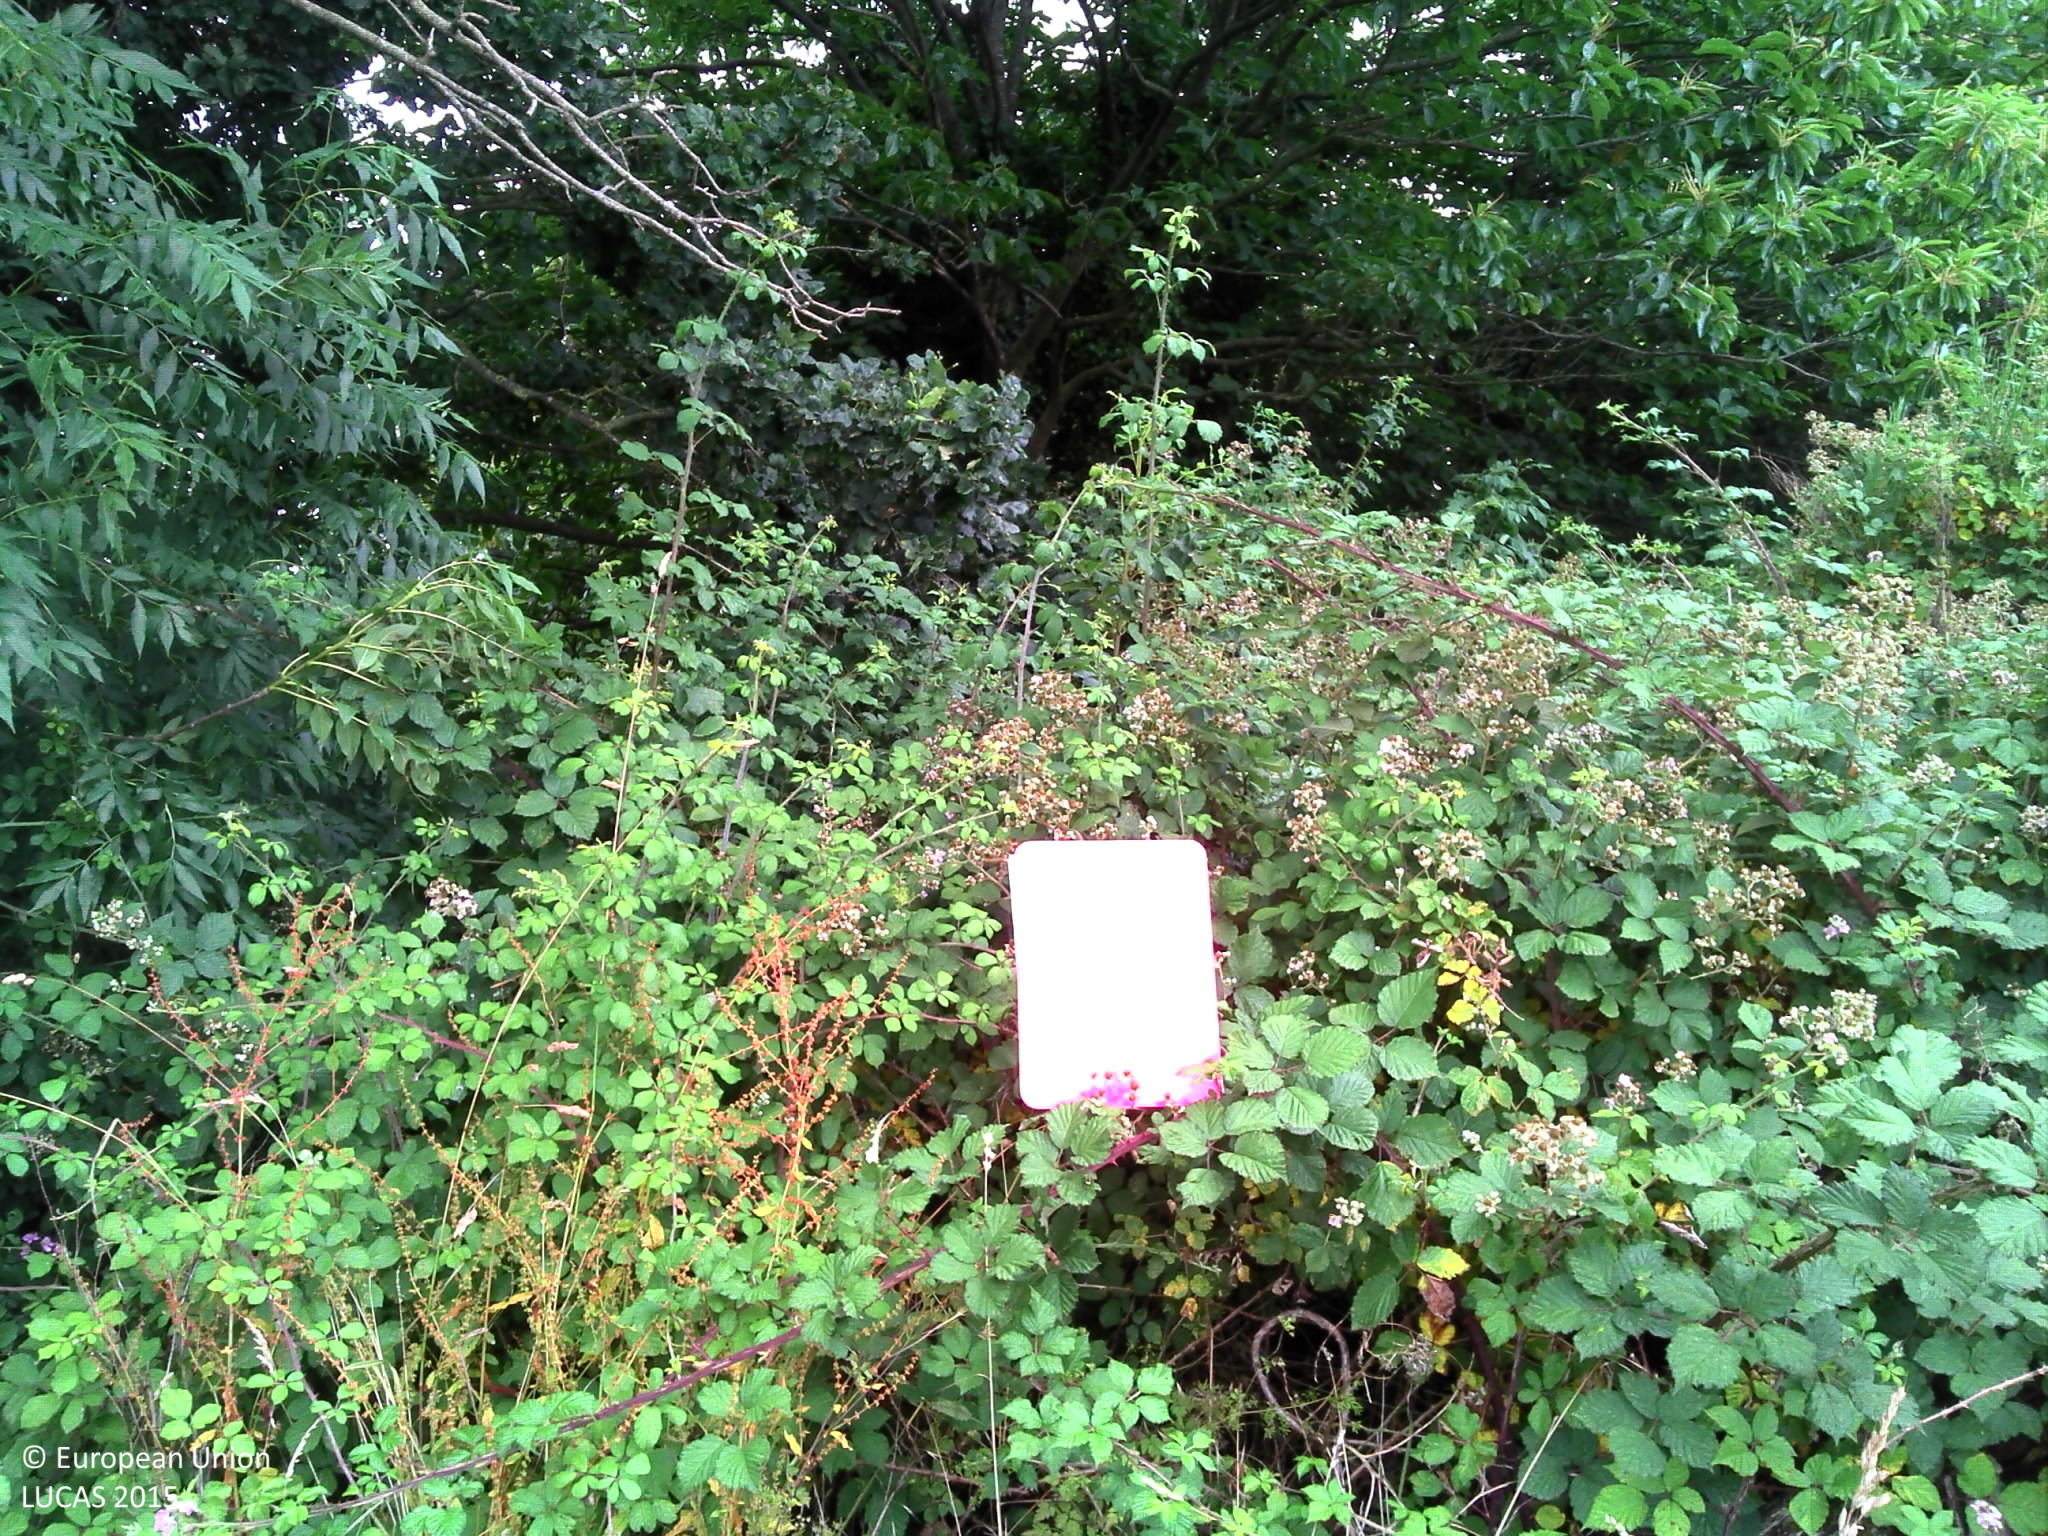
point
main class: Woodland
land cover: Broadleaved woodland
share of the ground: > 75 %
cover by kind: herbaceous plants 50 %, shrubs 35 %, broadleaved forest trees 15 %
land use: Semi-natural and natural areas not in use
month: July
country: FR
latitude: 47.8343
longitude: -1.3585
